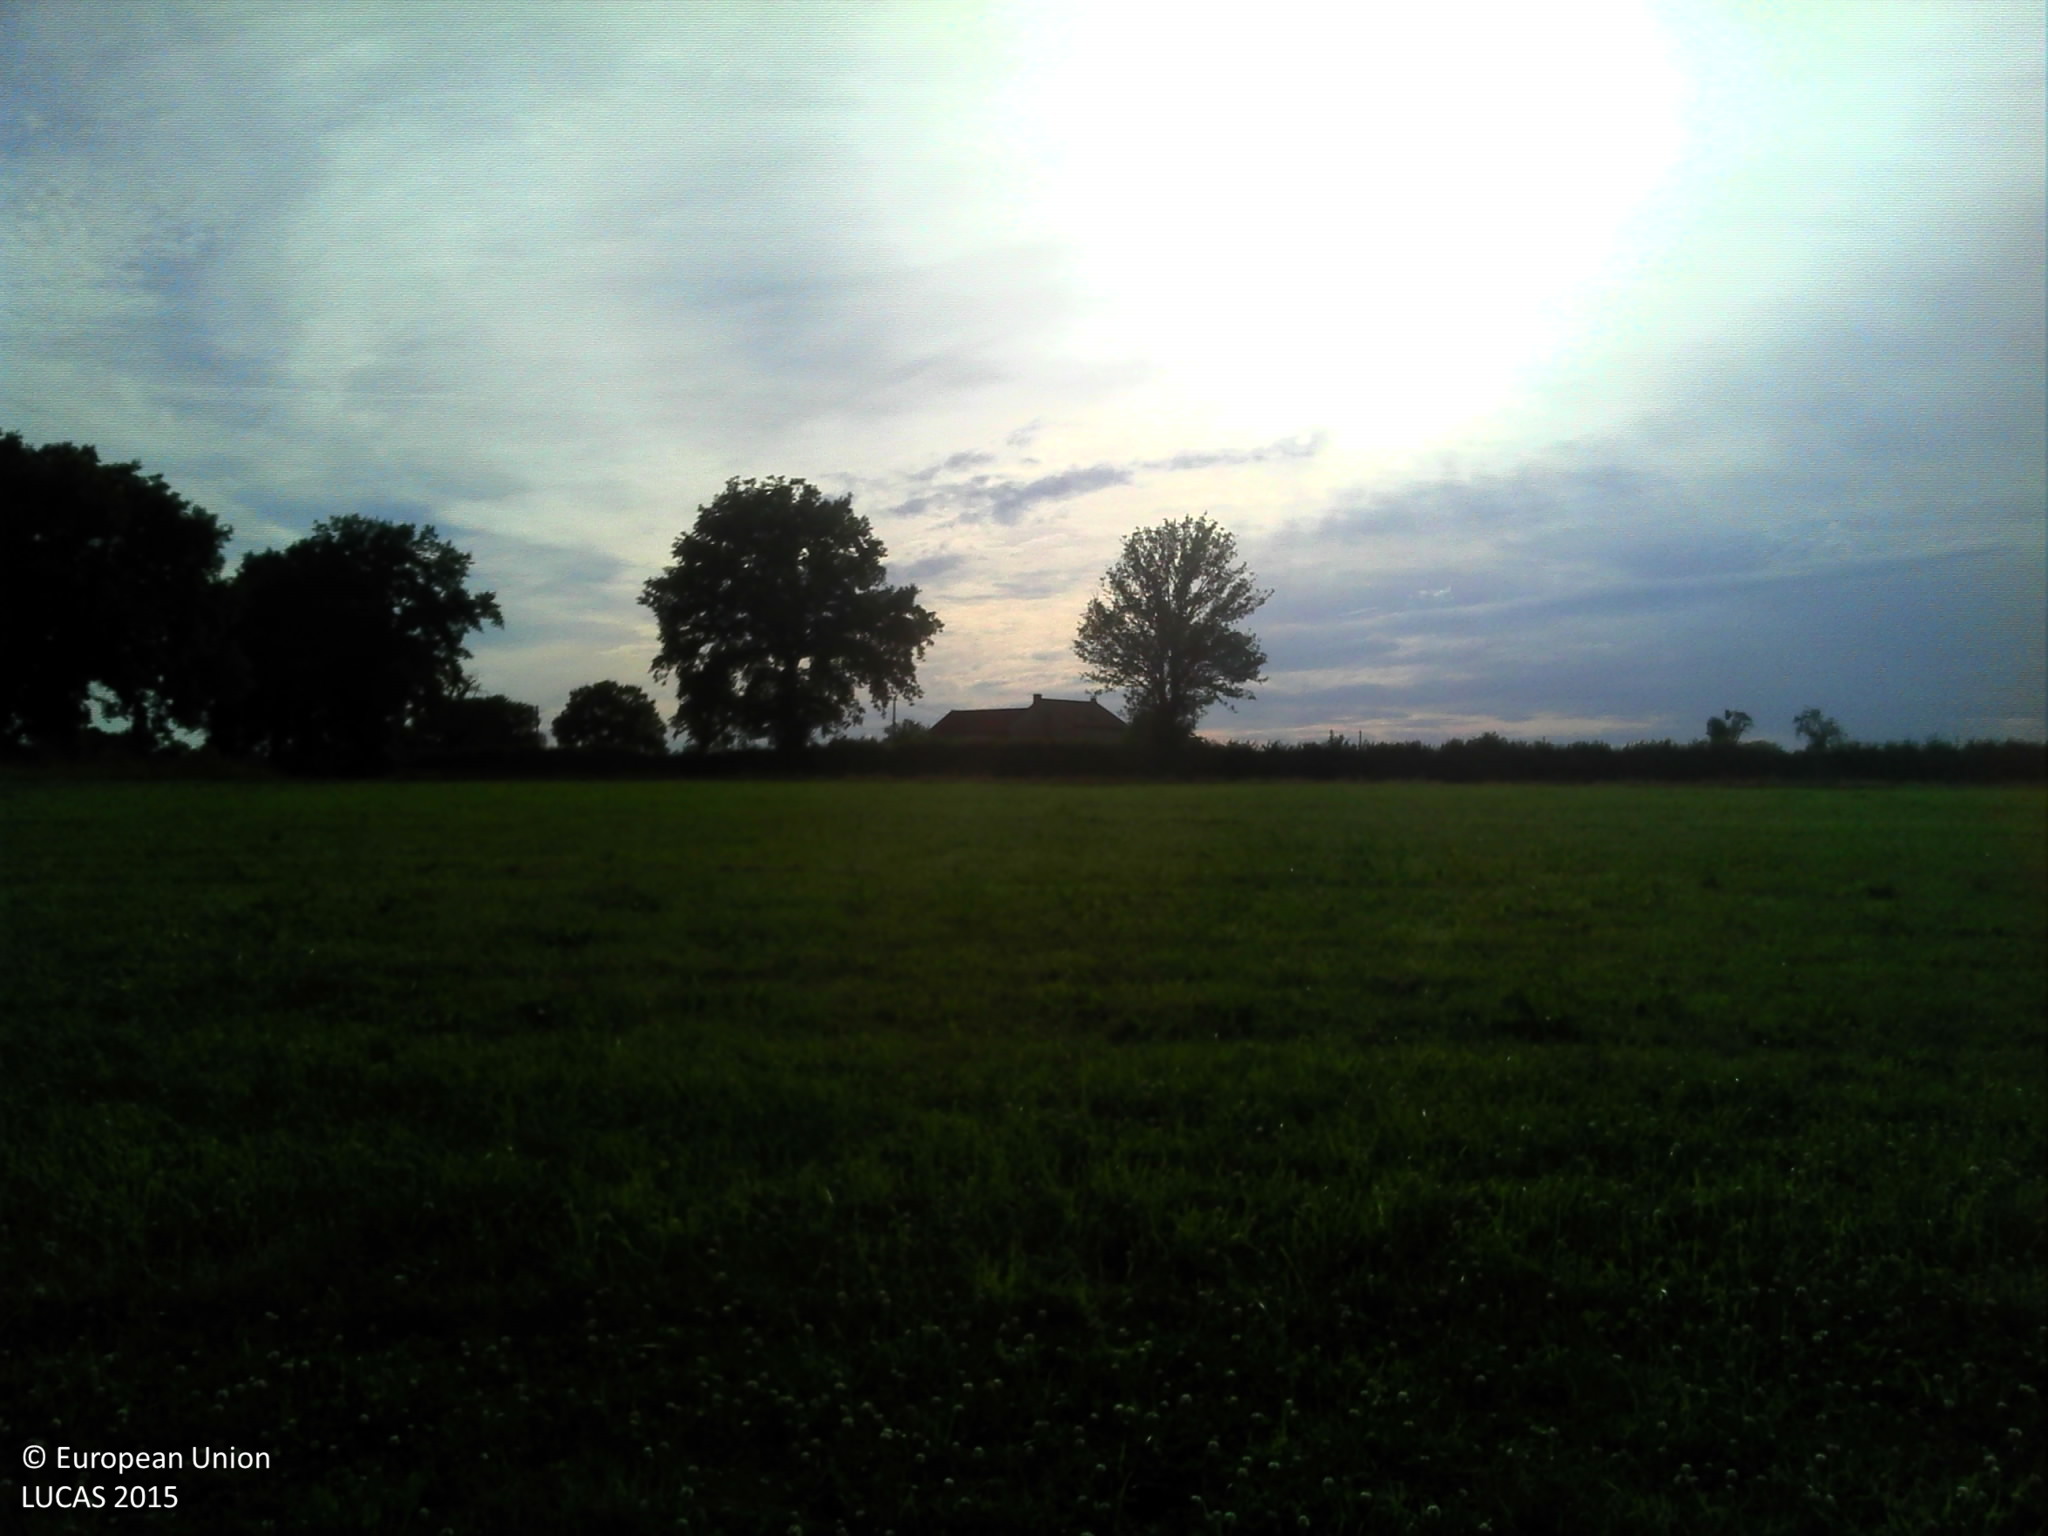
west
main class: Cropland
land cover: Temporary grasslands
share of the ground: > 75 %
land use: Agriculture (excluding fallow land and kitchen gardens)
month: June
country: FR
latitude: 46.4744
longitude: 4.0484
